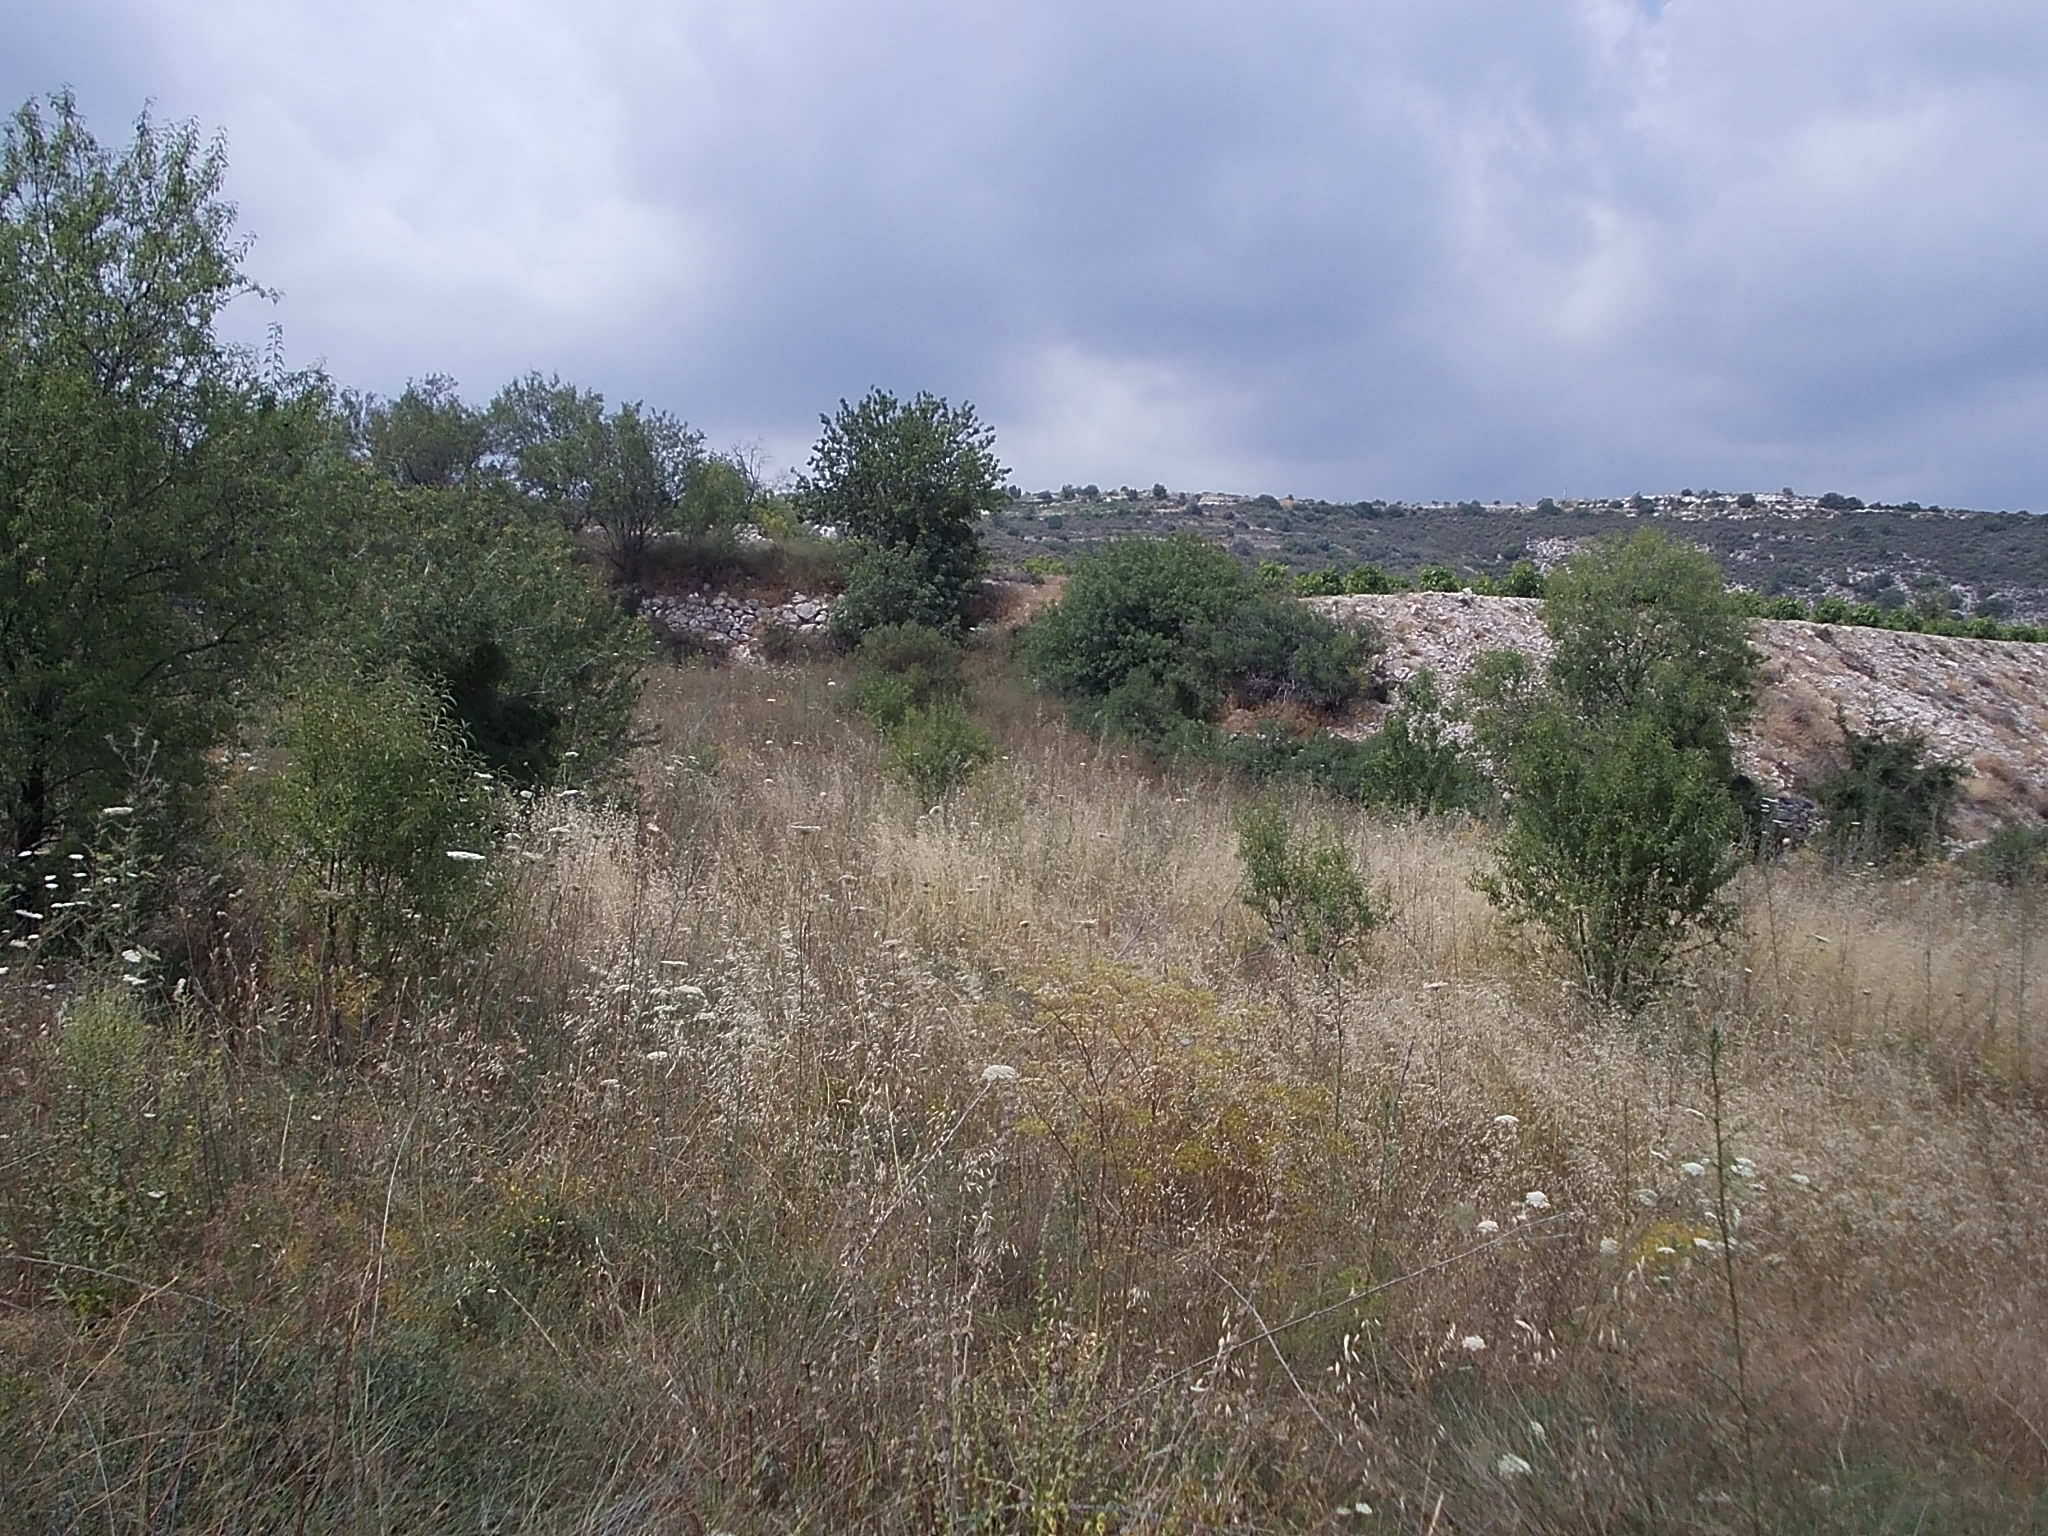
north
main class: Grassland
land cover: Grassland with sparse tree/shrub cover
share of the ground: > 75 %
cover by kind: herbaceous plants 95 %, broadleaved forest trees 5 %
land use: Semi-natural and natural areas not in use
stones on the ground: 10 - 25 %
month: June
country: CY
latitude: 34.8278
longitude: 32.9411
